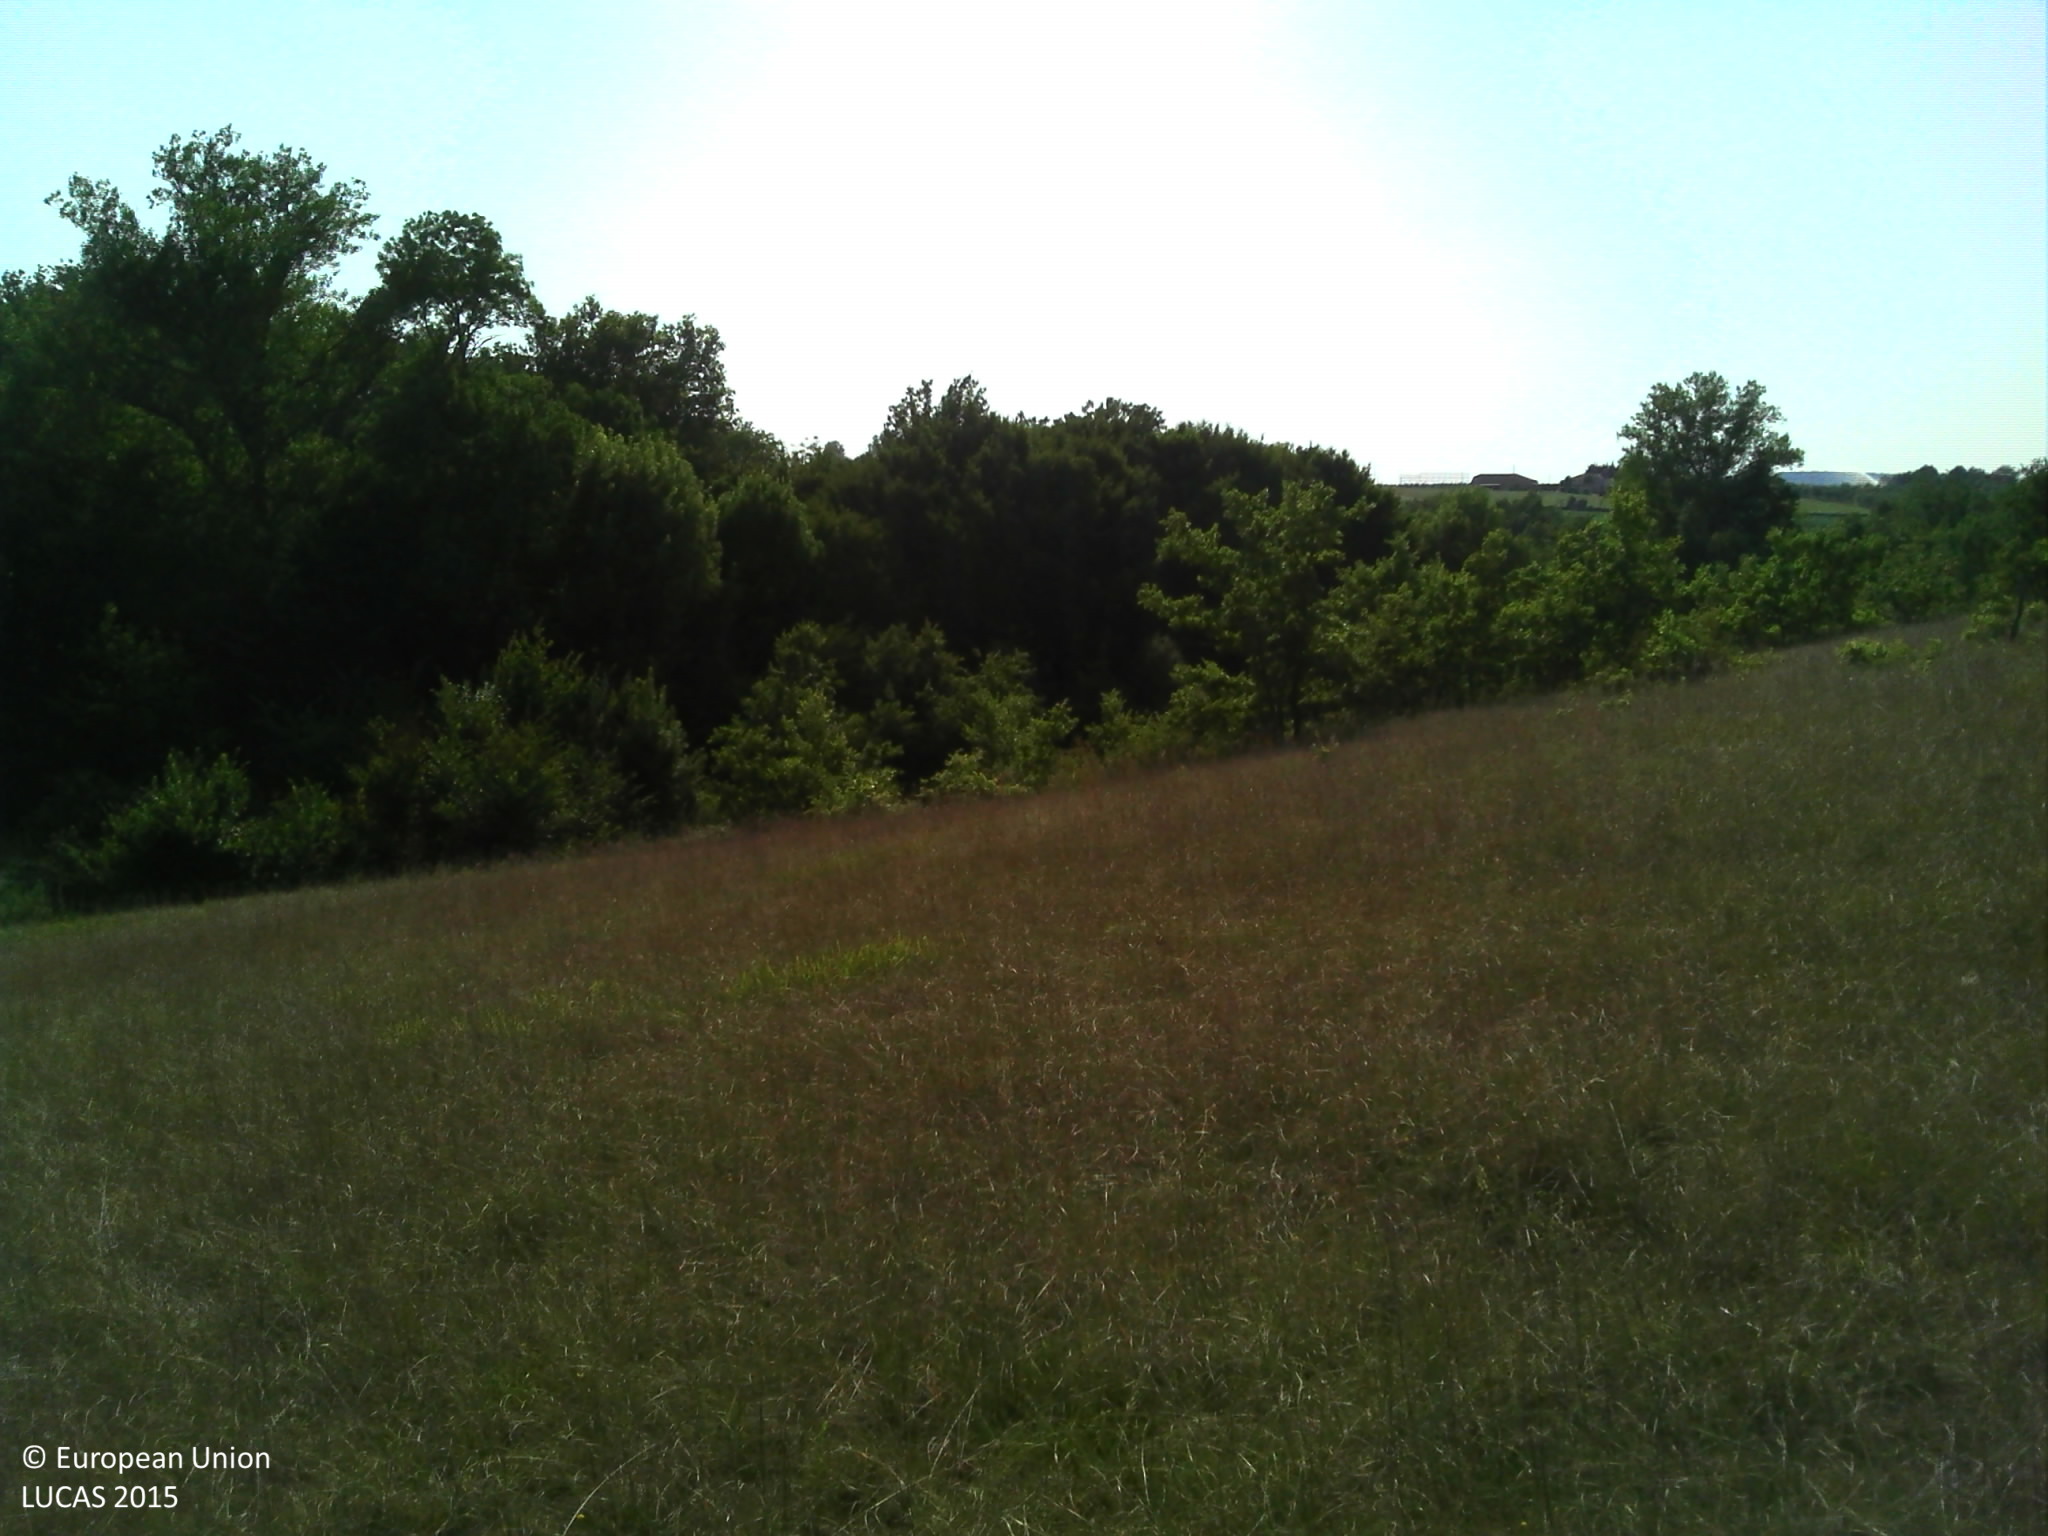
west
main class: Grassland
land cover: Grassland with sparse tree/shrub cover
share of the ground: > 75 %
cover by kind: herbaceous plants 90 %, broadleaved forest trees 5 %, shrubs 5 %
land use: Agriculture (excluding fallow land and kitchen gardens)
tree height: < 5 m
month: July
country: FR
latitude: 44.4229
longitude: 0.9141
